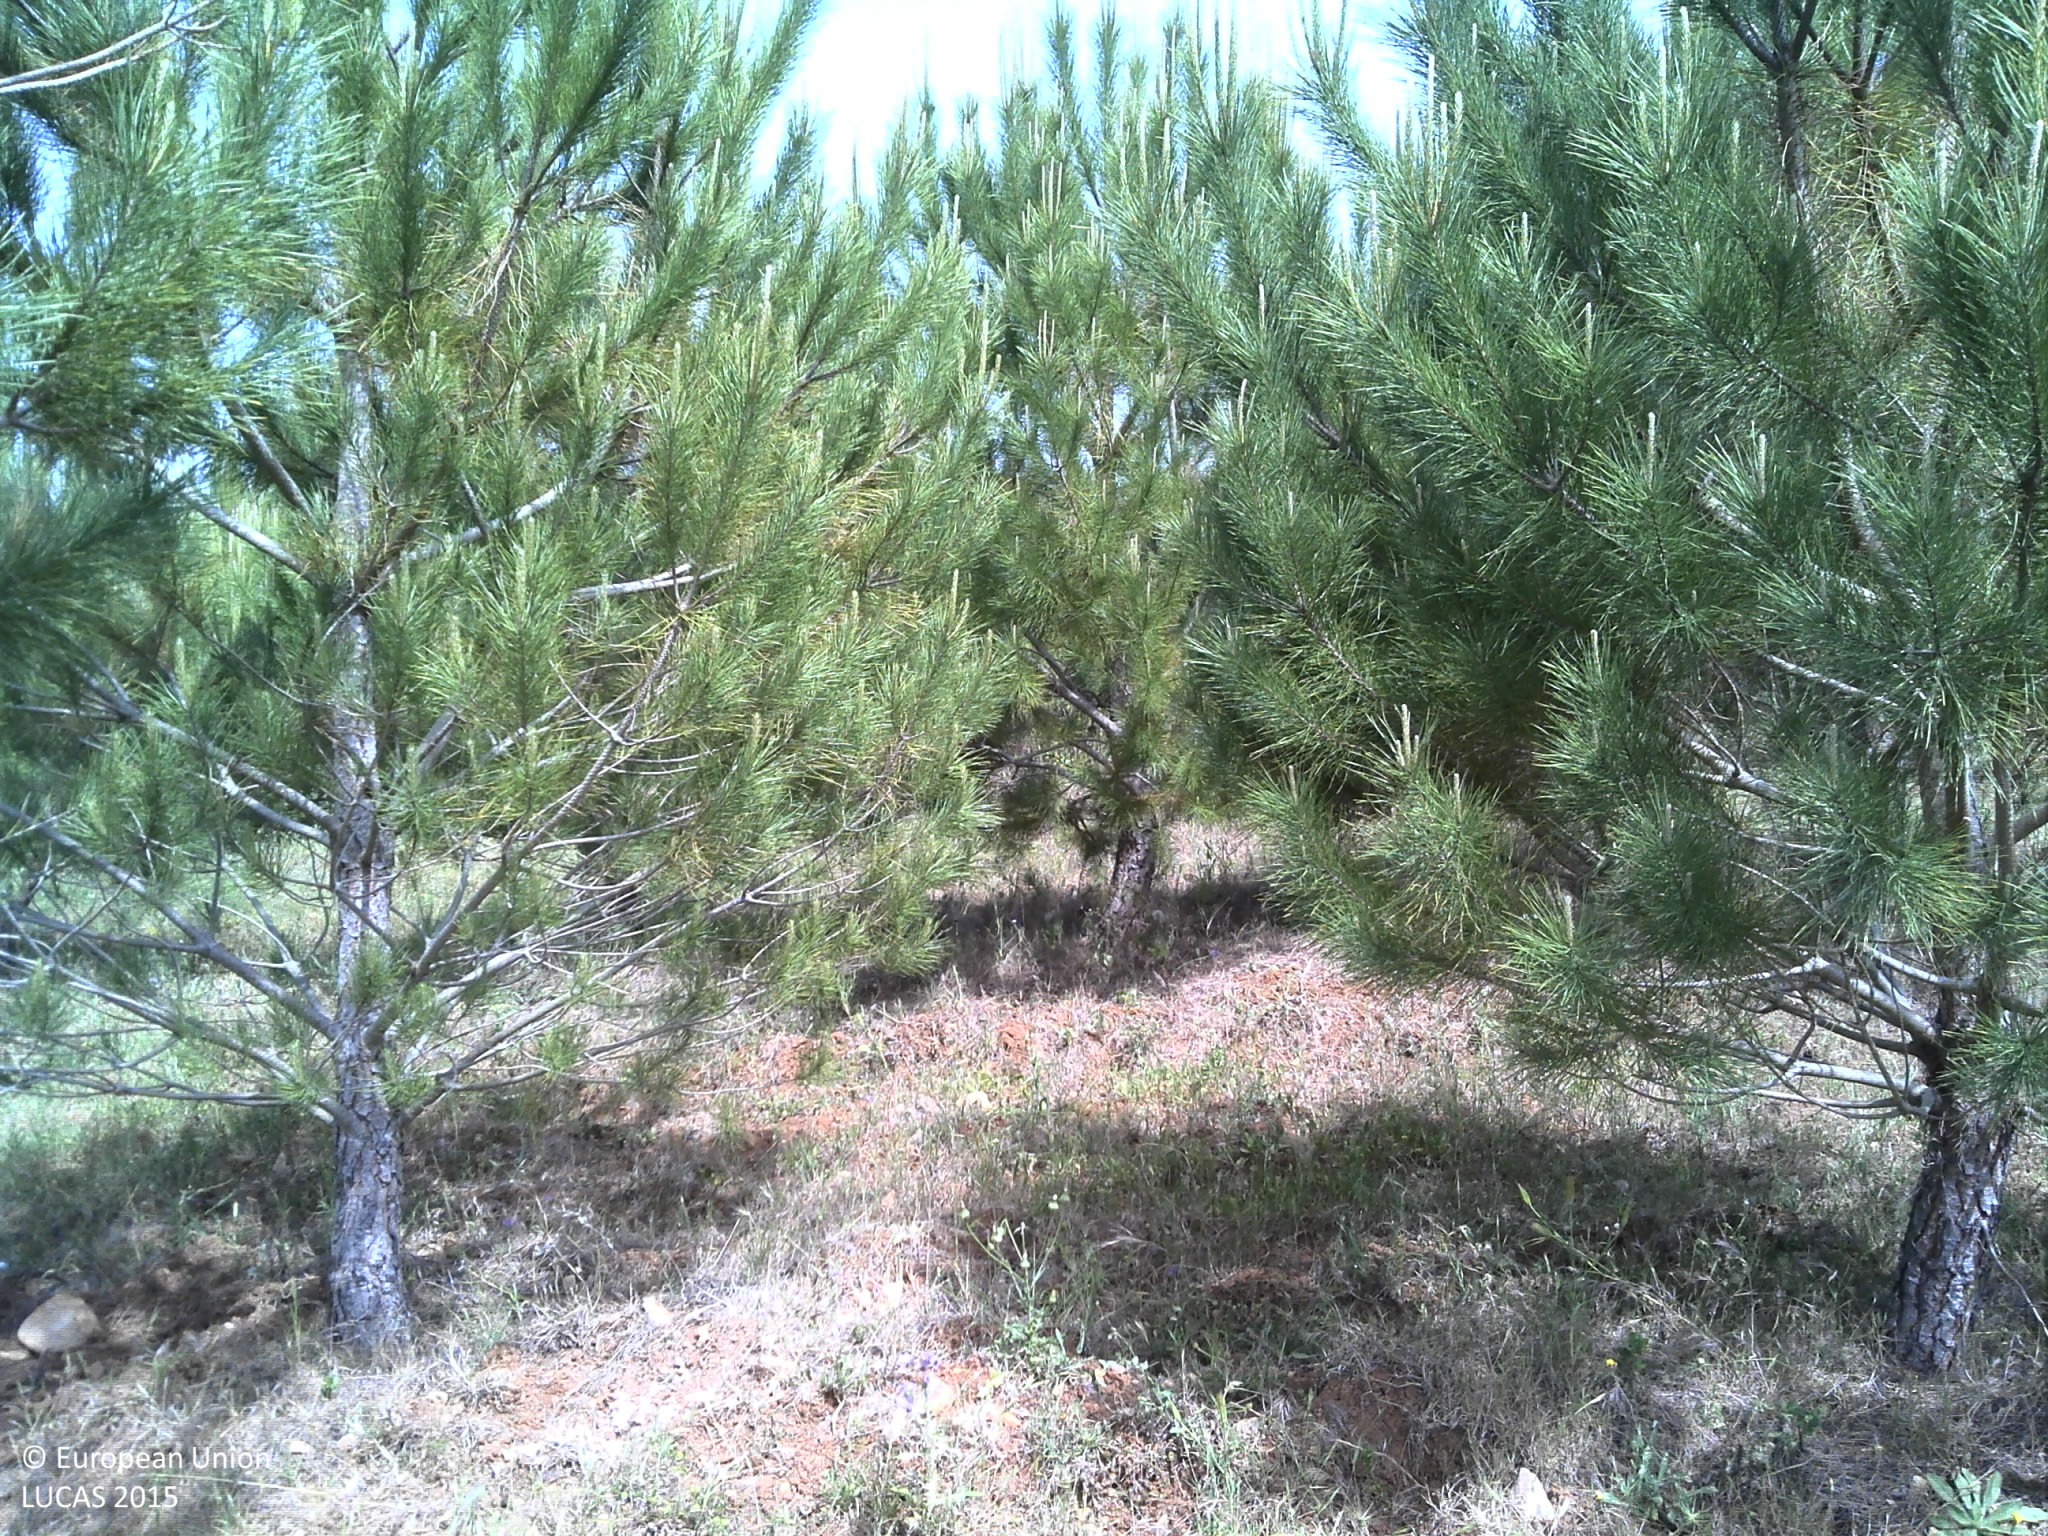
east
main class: Woodland
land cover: Pine dominated coniferous woodland
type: coniferous forest of the mediterranean region
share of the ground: 50 - 75 %
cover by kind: coniferous forest trees 65 %, herbaceous plants 30 %, unconsolidated bare surface 5 %
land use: Forestry
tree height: < 5 m
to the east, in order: Pine dominated coniferous woodland; Spontaneously vegetated surfaces; Broadleaved woodland; Tracks; Broadleaved woodland; Tracks; Fences; Broadleaved woodland; Spontaneously vegetated surfaces; Tracks; Fences; Pine dominated coniferous woodland
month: May
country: PT
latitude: 38.3764
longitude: -8.4207
